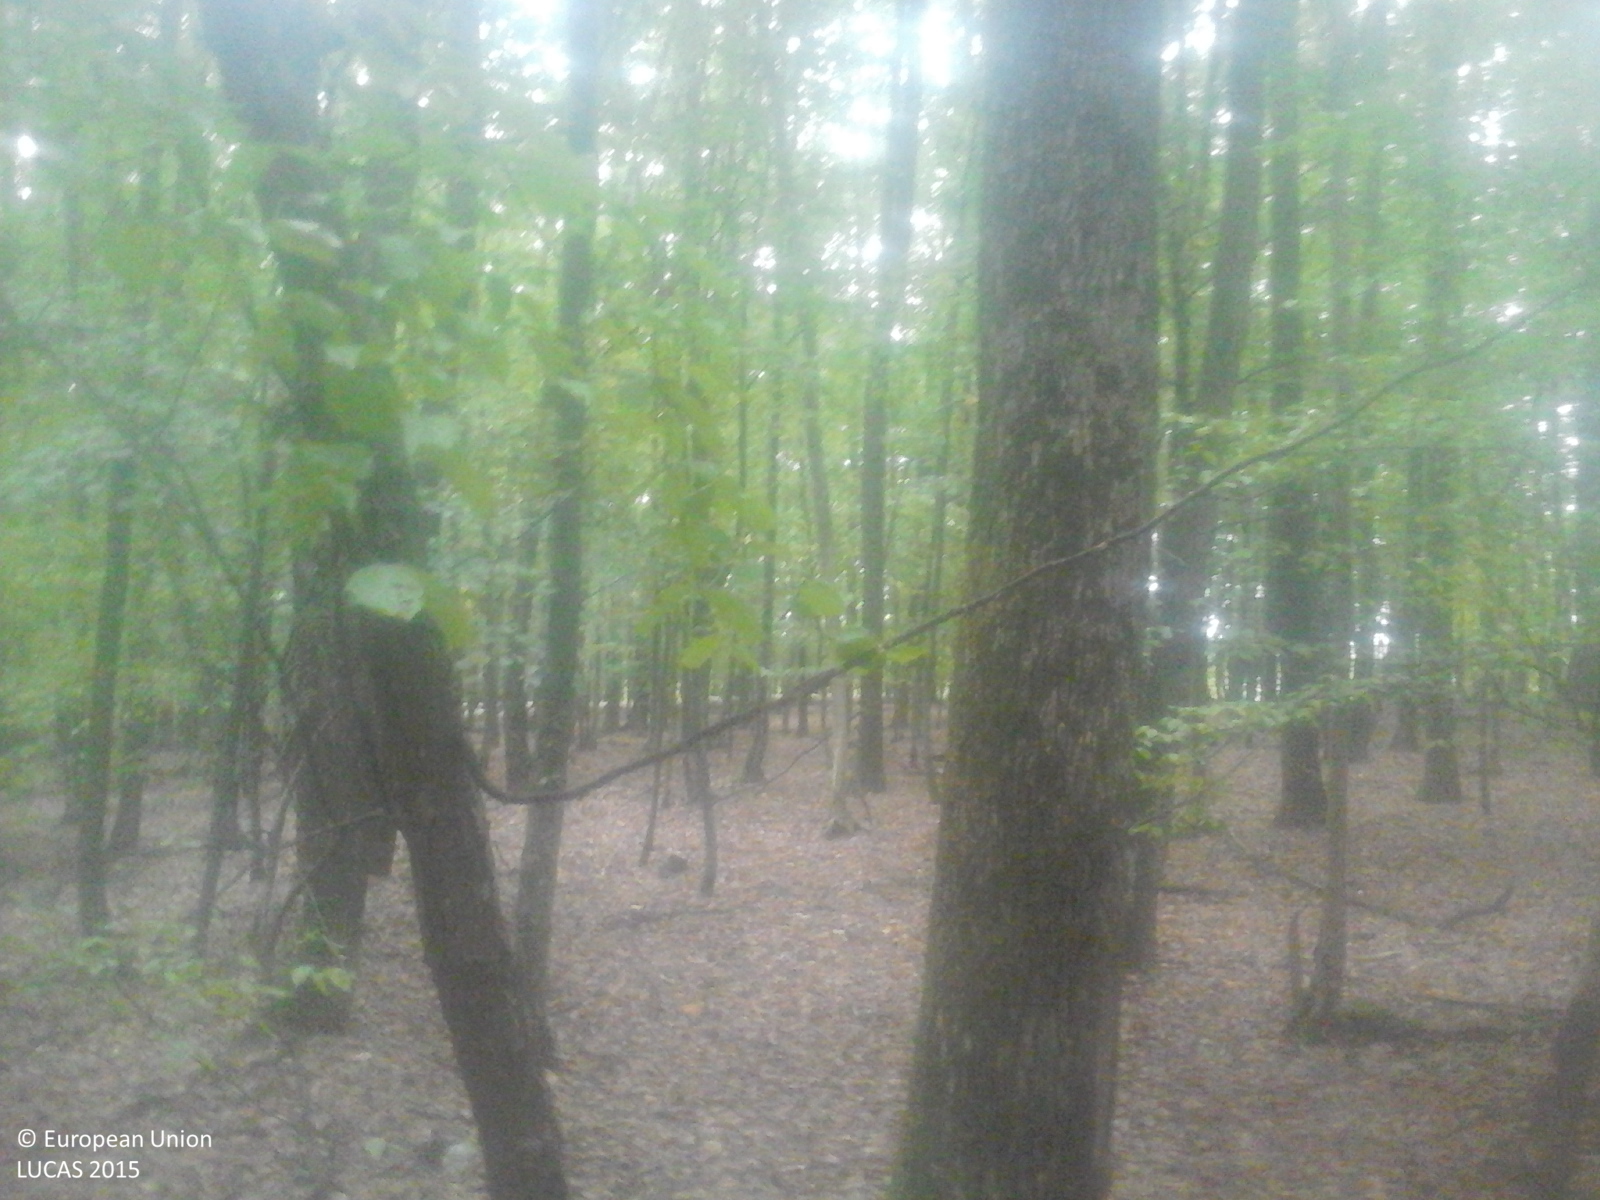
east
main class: Woodland
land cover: Broadleaved woodland
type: beech forest
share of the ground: > 75 %
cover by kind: broadleaved forest trees 100 %
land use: Forestry
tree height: > 5 m
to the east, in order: Broadleaved woodland; Tracks; Grassland with sparse tree/shrub cover; Tracks; Broadleaved woodland
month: September
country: RO
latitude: 45.5113
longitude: 21.9809
